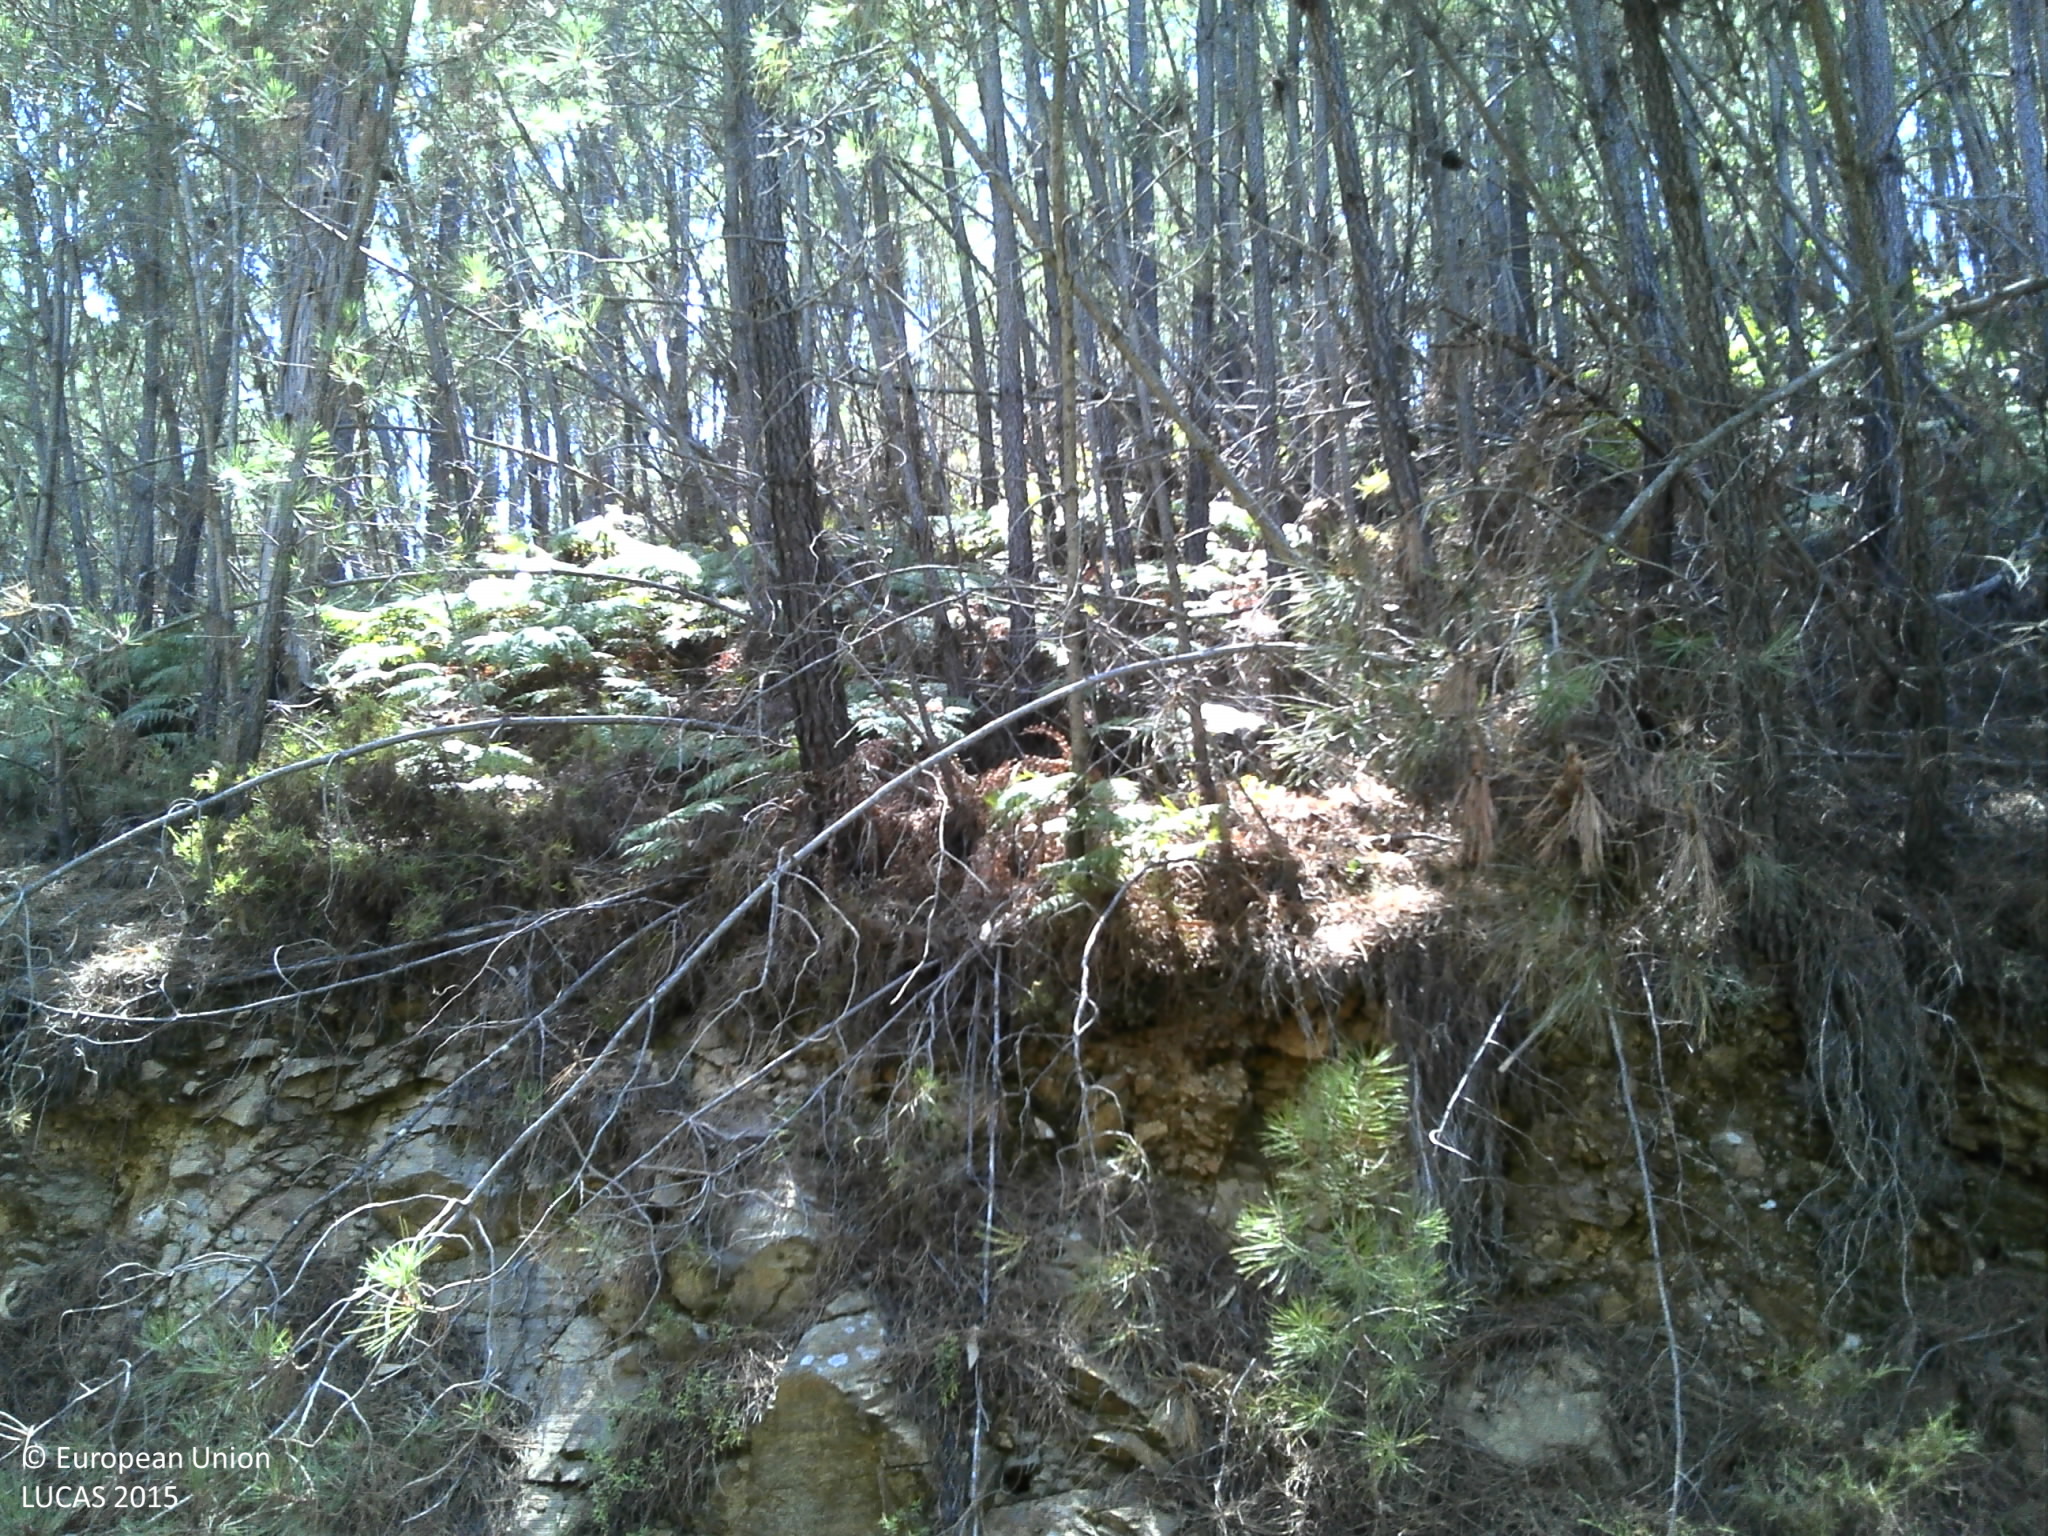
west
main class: Woodland
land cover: Pine dominated coniferous woodland
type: coniferous forest of the mediterranean region
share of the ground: 10 - 25 %
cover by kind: shrubs 80 %, coniferous forest trees 15 %, unconsolidated bare surface 5 %
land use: Forestry
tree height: > 5 m
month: July
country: PT
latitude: 39.9309
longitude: -8.1257
